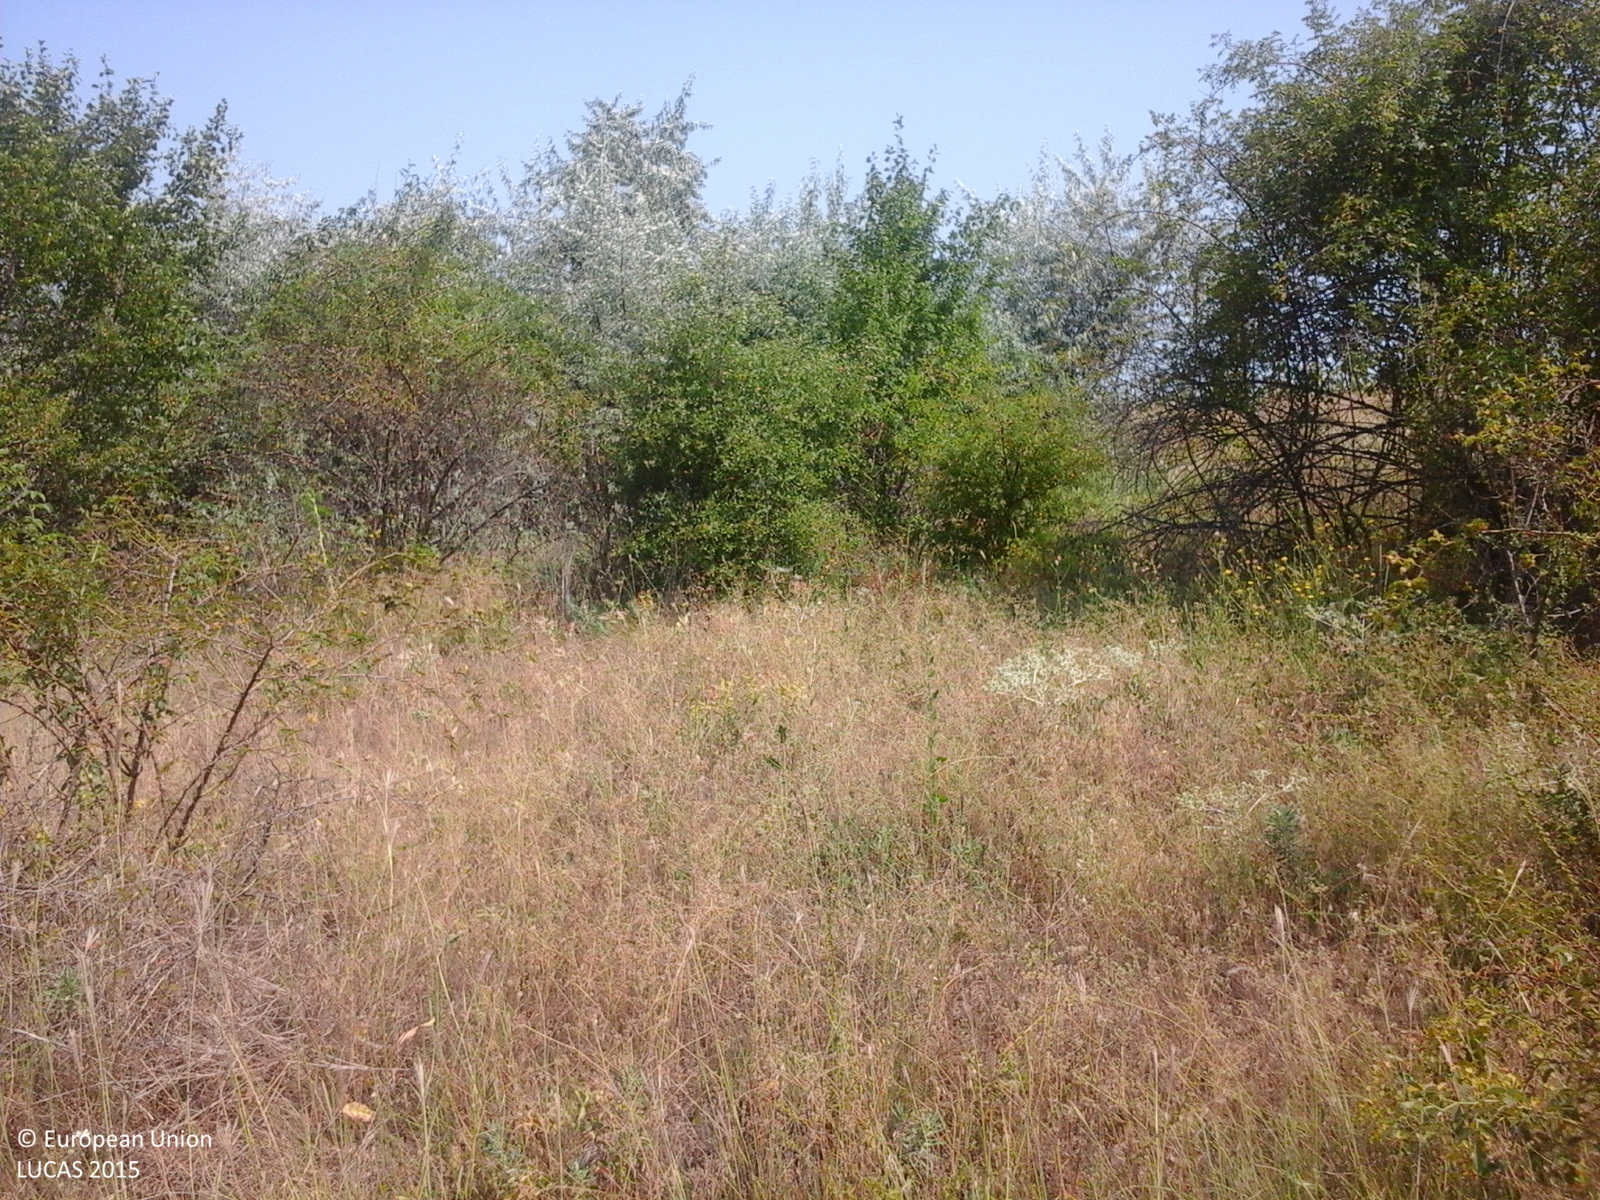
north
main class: Grassland
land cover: Grassland with sparse tree/shrub cover
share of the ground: > 75 %
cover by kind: herbaceous plants 95 %, broadleaved forest trees 5 %
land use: Semi-natural and natural areas not in use
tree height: < 5 m
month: July
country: RO
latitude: 45.9613
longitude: 27.9396
